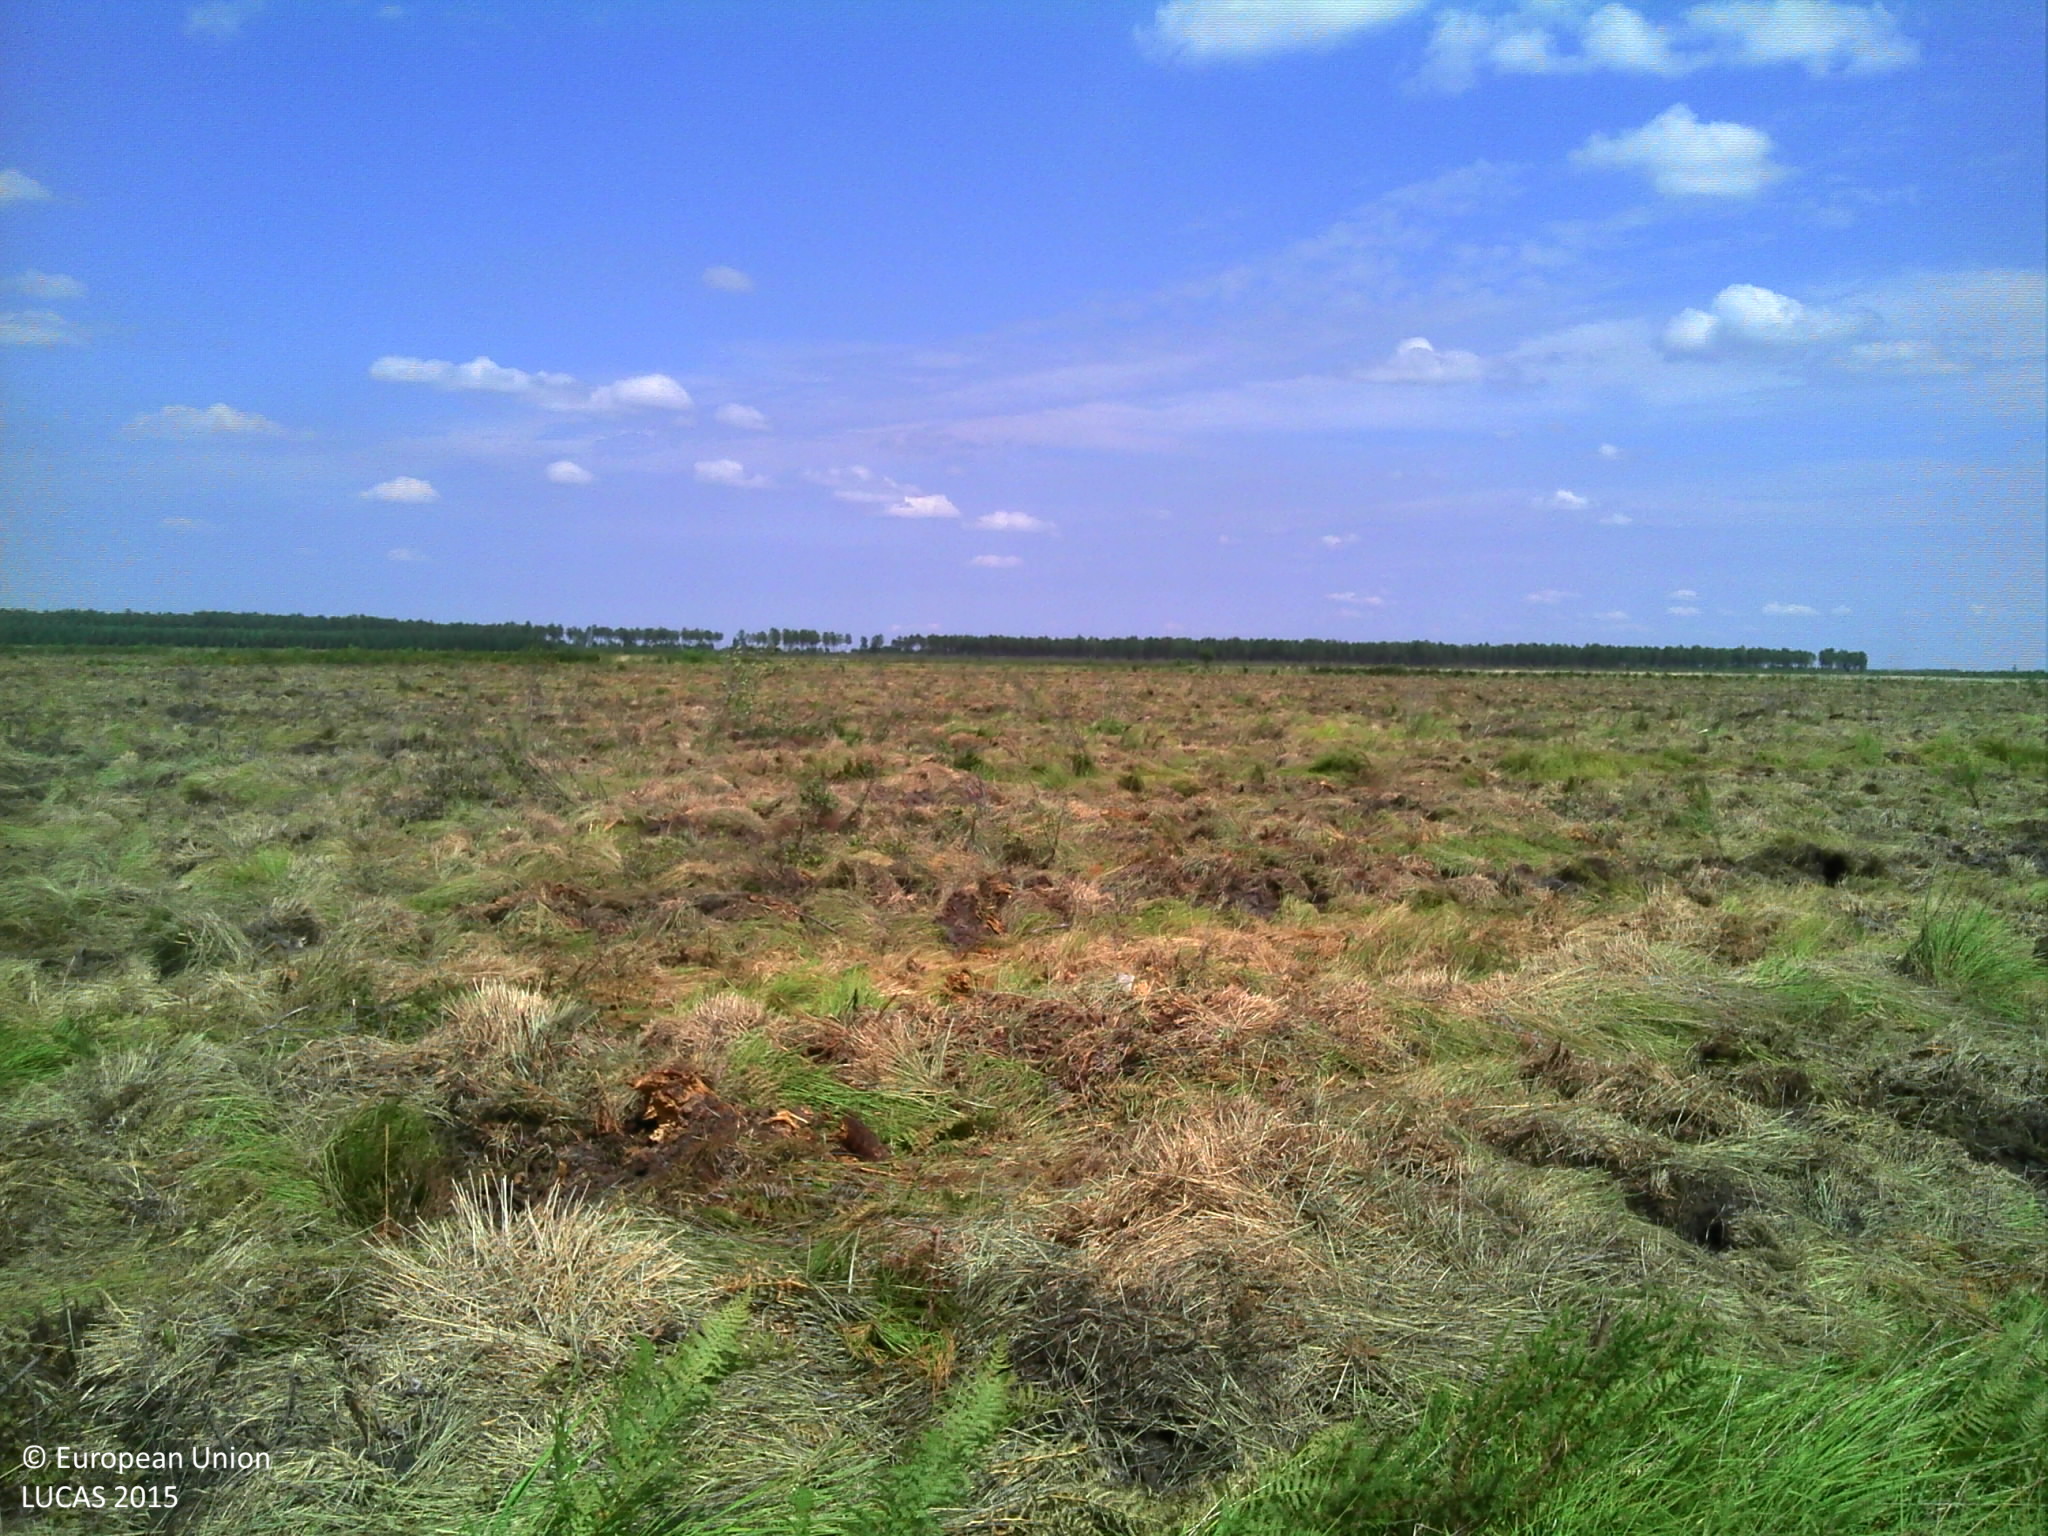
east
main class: Grassland
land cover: Spontaneously vegetated surfaces
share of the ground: > 75 %
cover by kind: herbaceous plants 100 %
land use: Forestry
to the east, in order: Spontaneously vegetated surfaces; Ditches and canals; Spontaneously vegetated surfaces
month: July
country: FR
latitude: 44.2198
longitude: -0.6424
